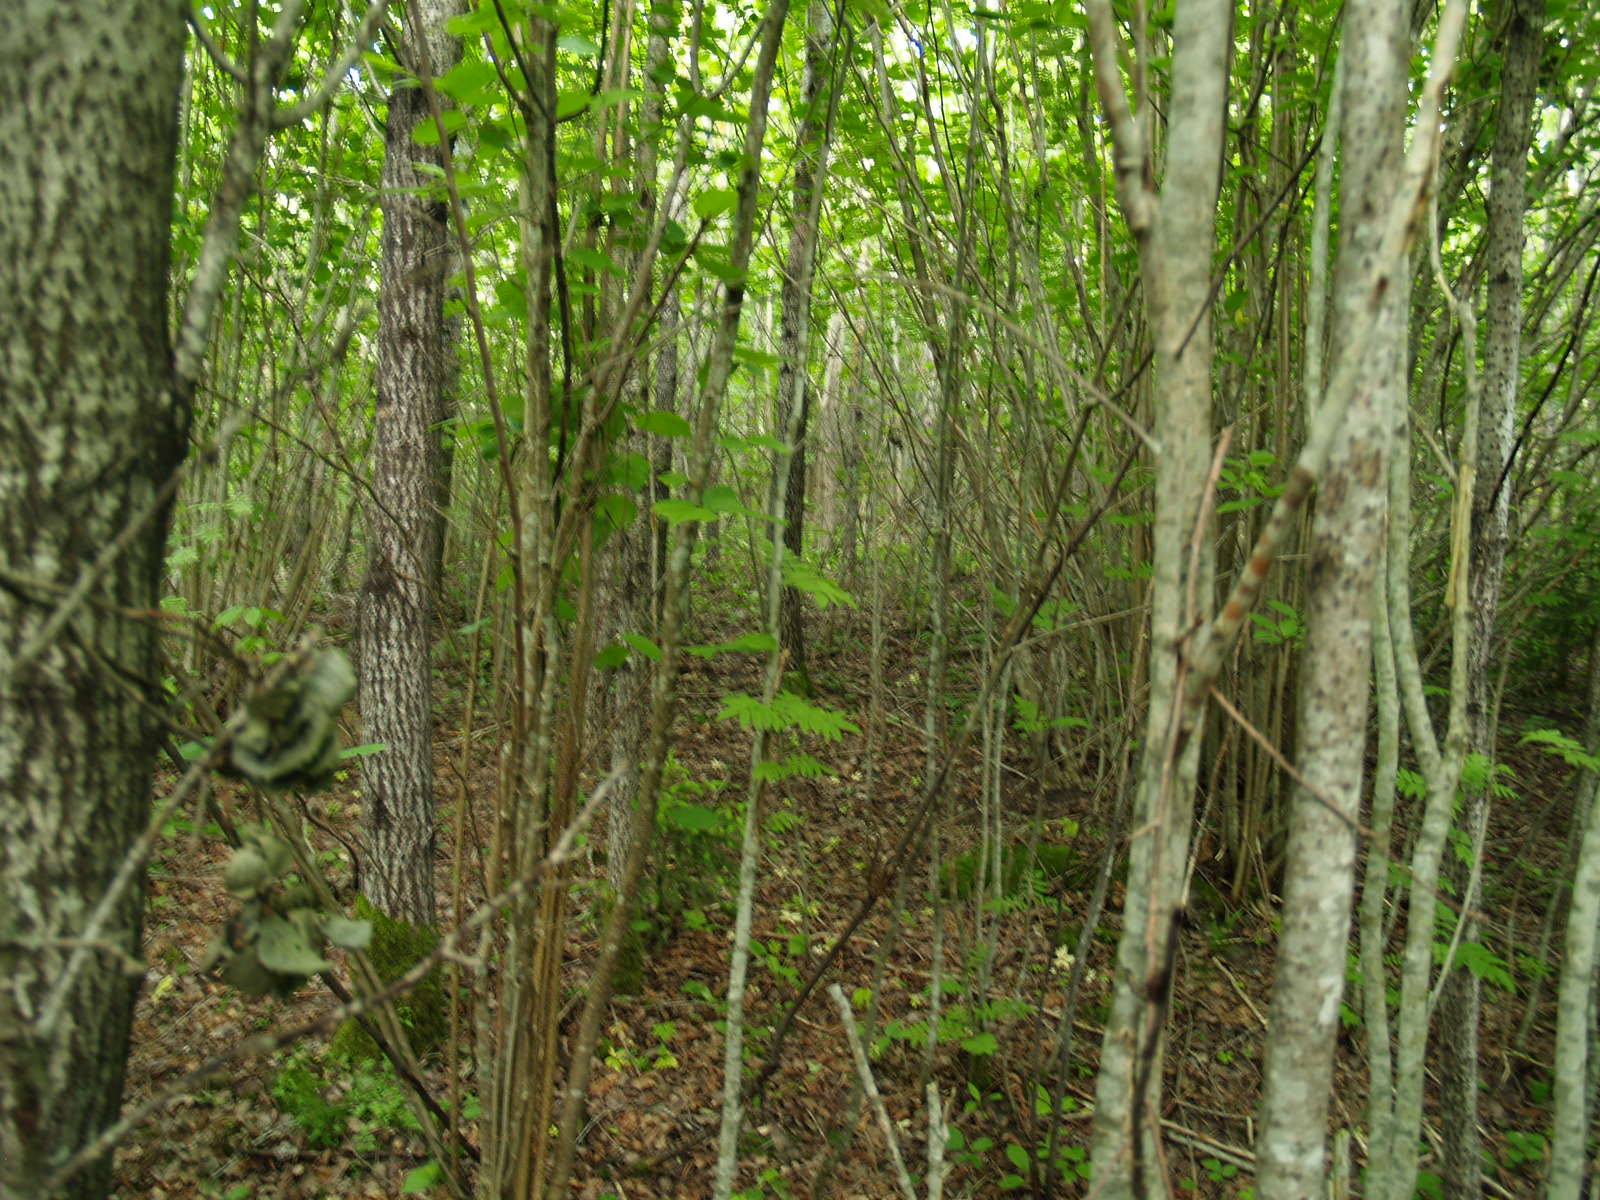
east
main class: Woodland
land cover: Broadleaved woodland
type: non-riverine alder, birch or aspen forest
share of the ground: > 75 %
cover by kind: broadleaved forest trees 100 %
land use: Forestry
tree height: > 5 m
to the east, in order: Broadleaved woodland; Tracks; Broadleaved woodland; Spruce dominated coniferous woodland; Broadleaved woodland; Grassland without tree/shrub cover
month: June
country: LV
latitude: 56.6275
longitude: 25.6911
